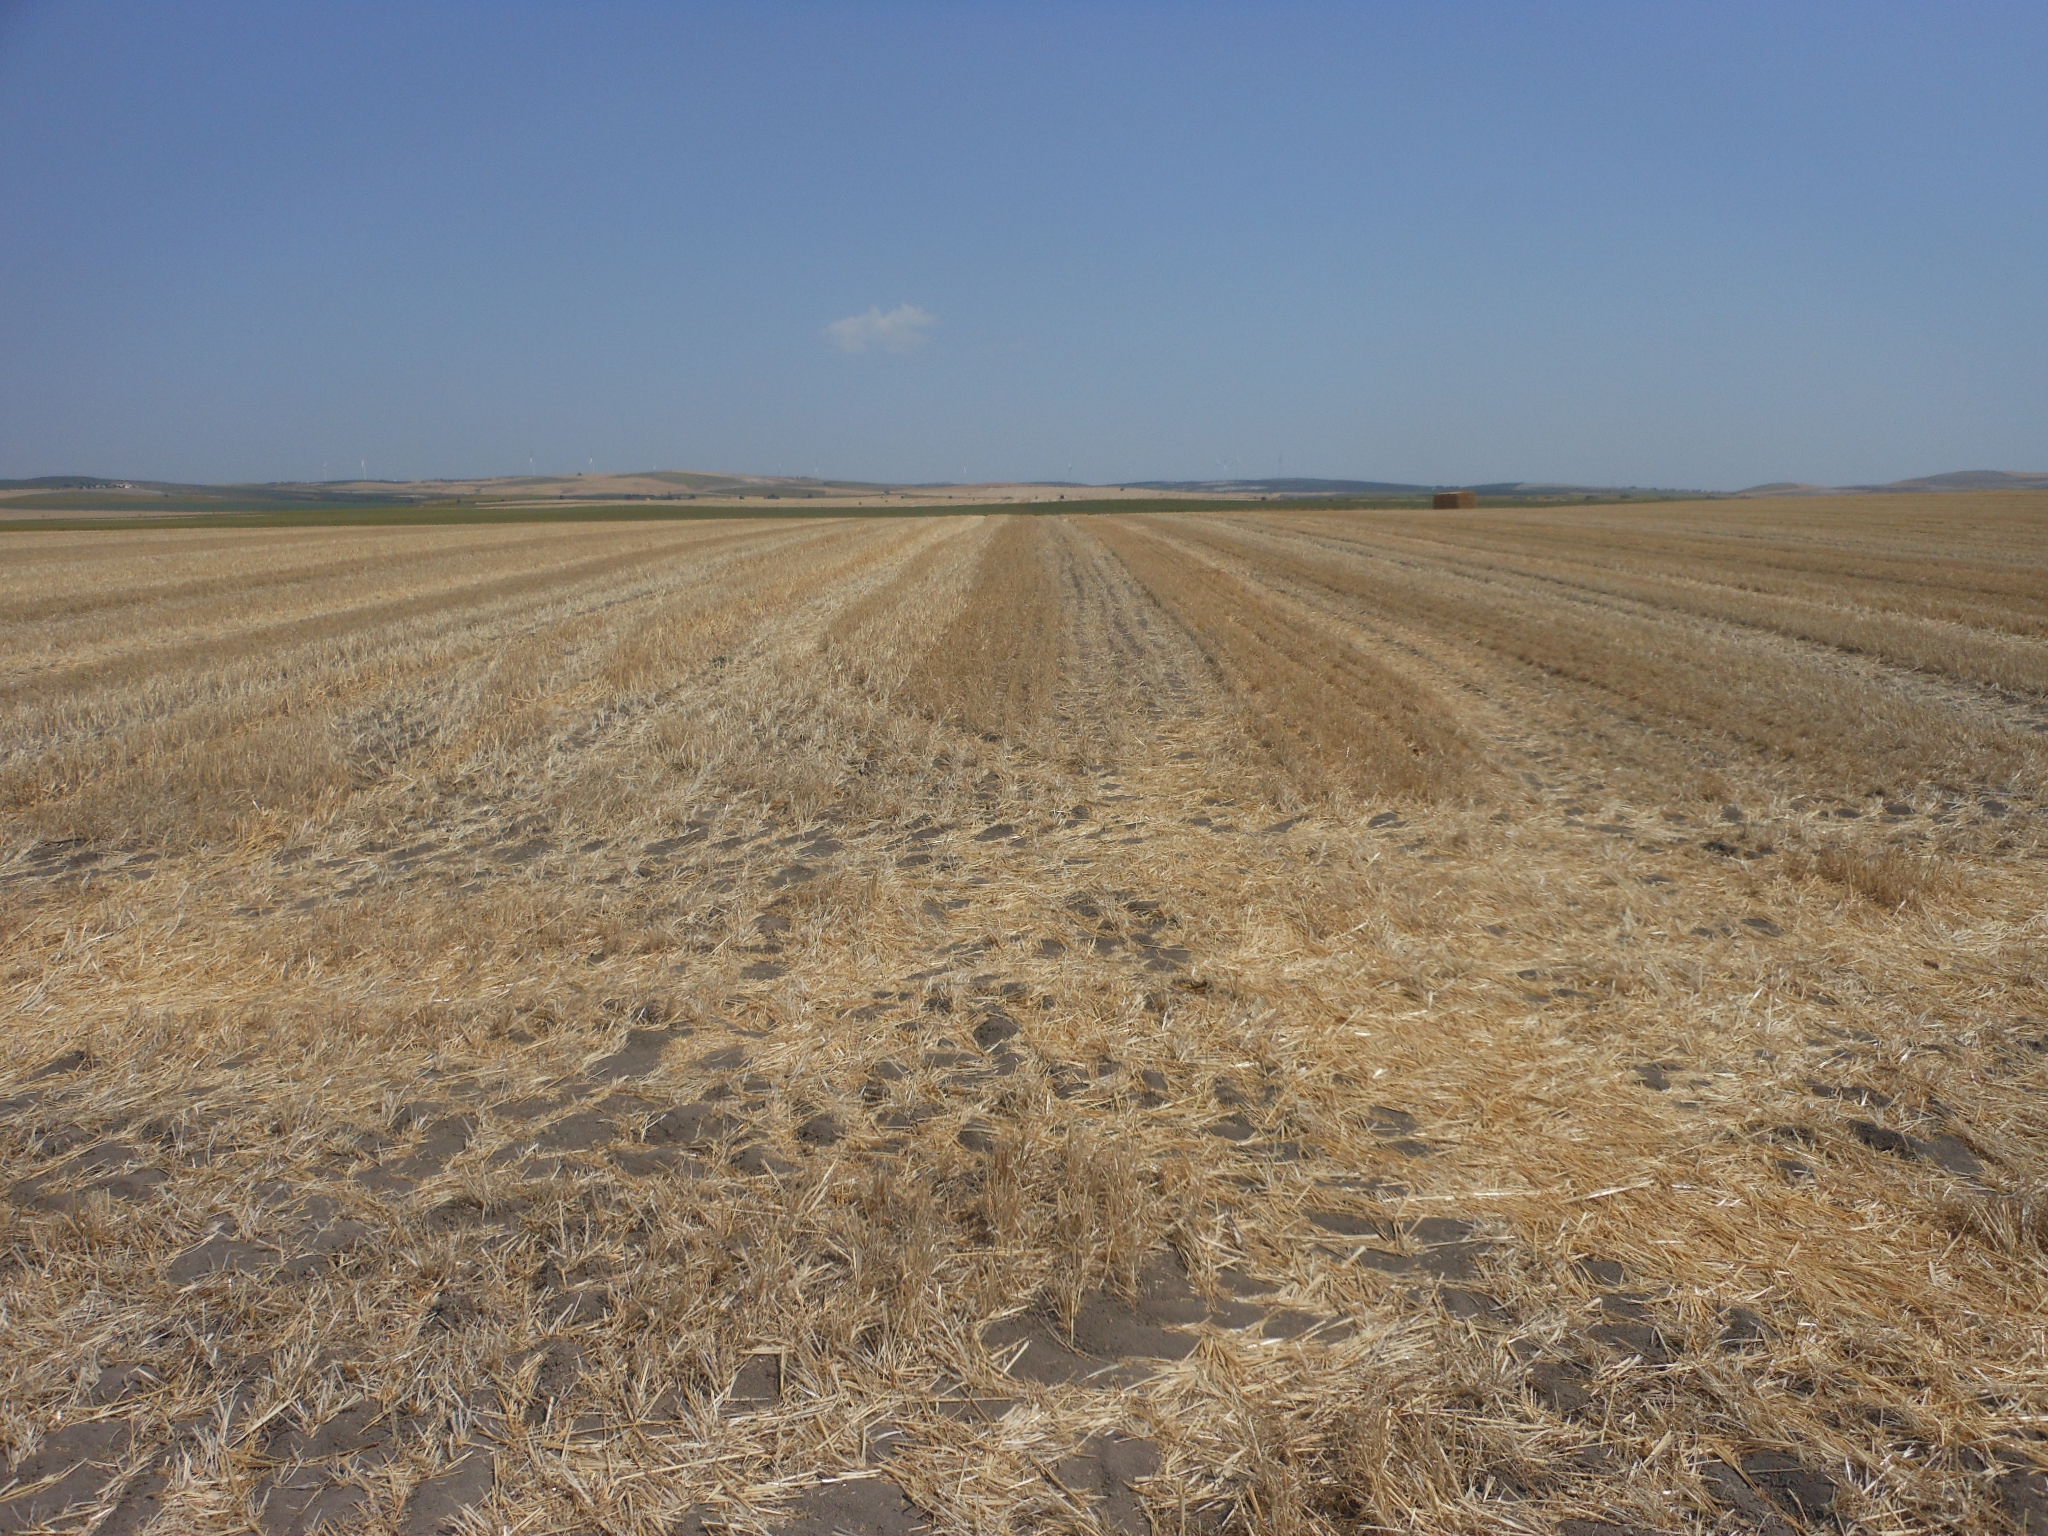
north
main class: Cropland
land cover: Durum wheat
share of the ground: < 10 %
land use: Agriculture (excluding fallow land and kitchen gardens)
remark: Harvested field
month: June
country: ES
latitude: 37.3937
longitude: -5.1355
